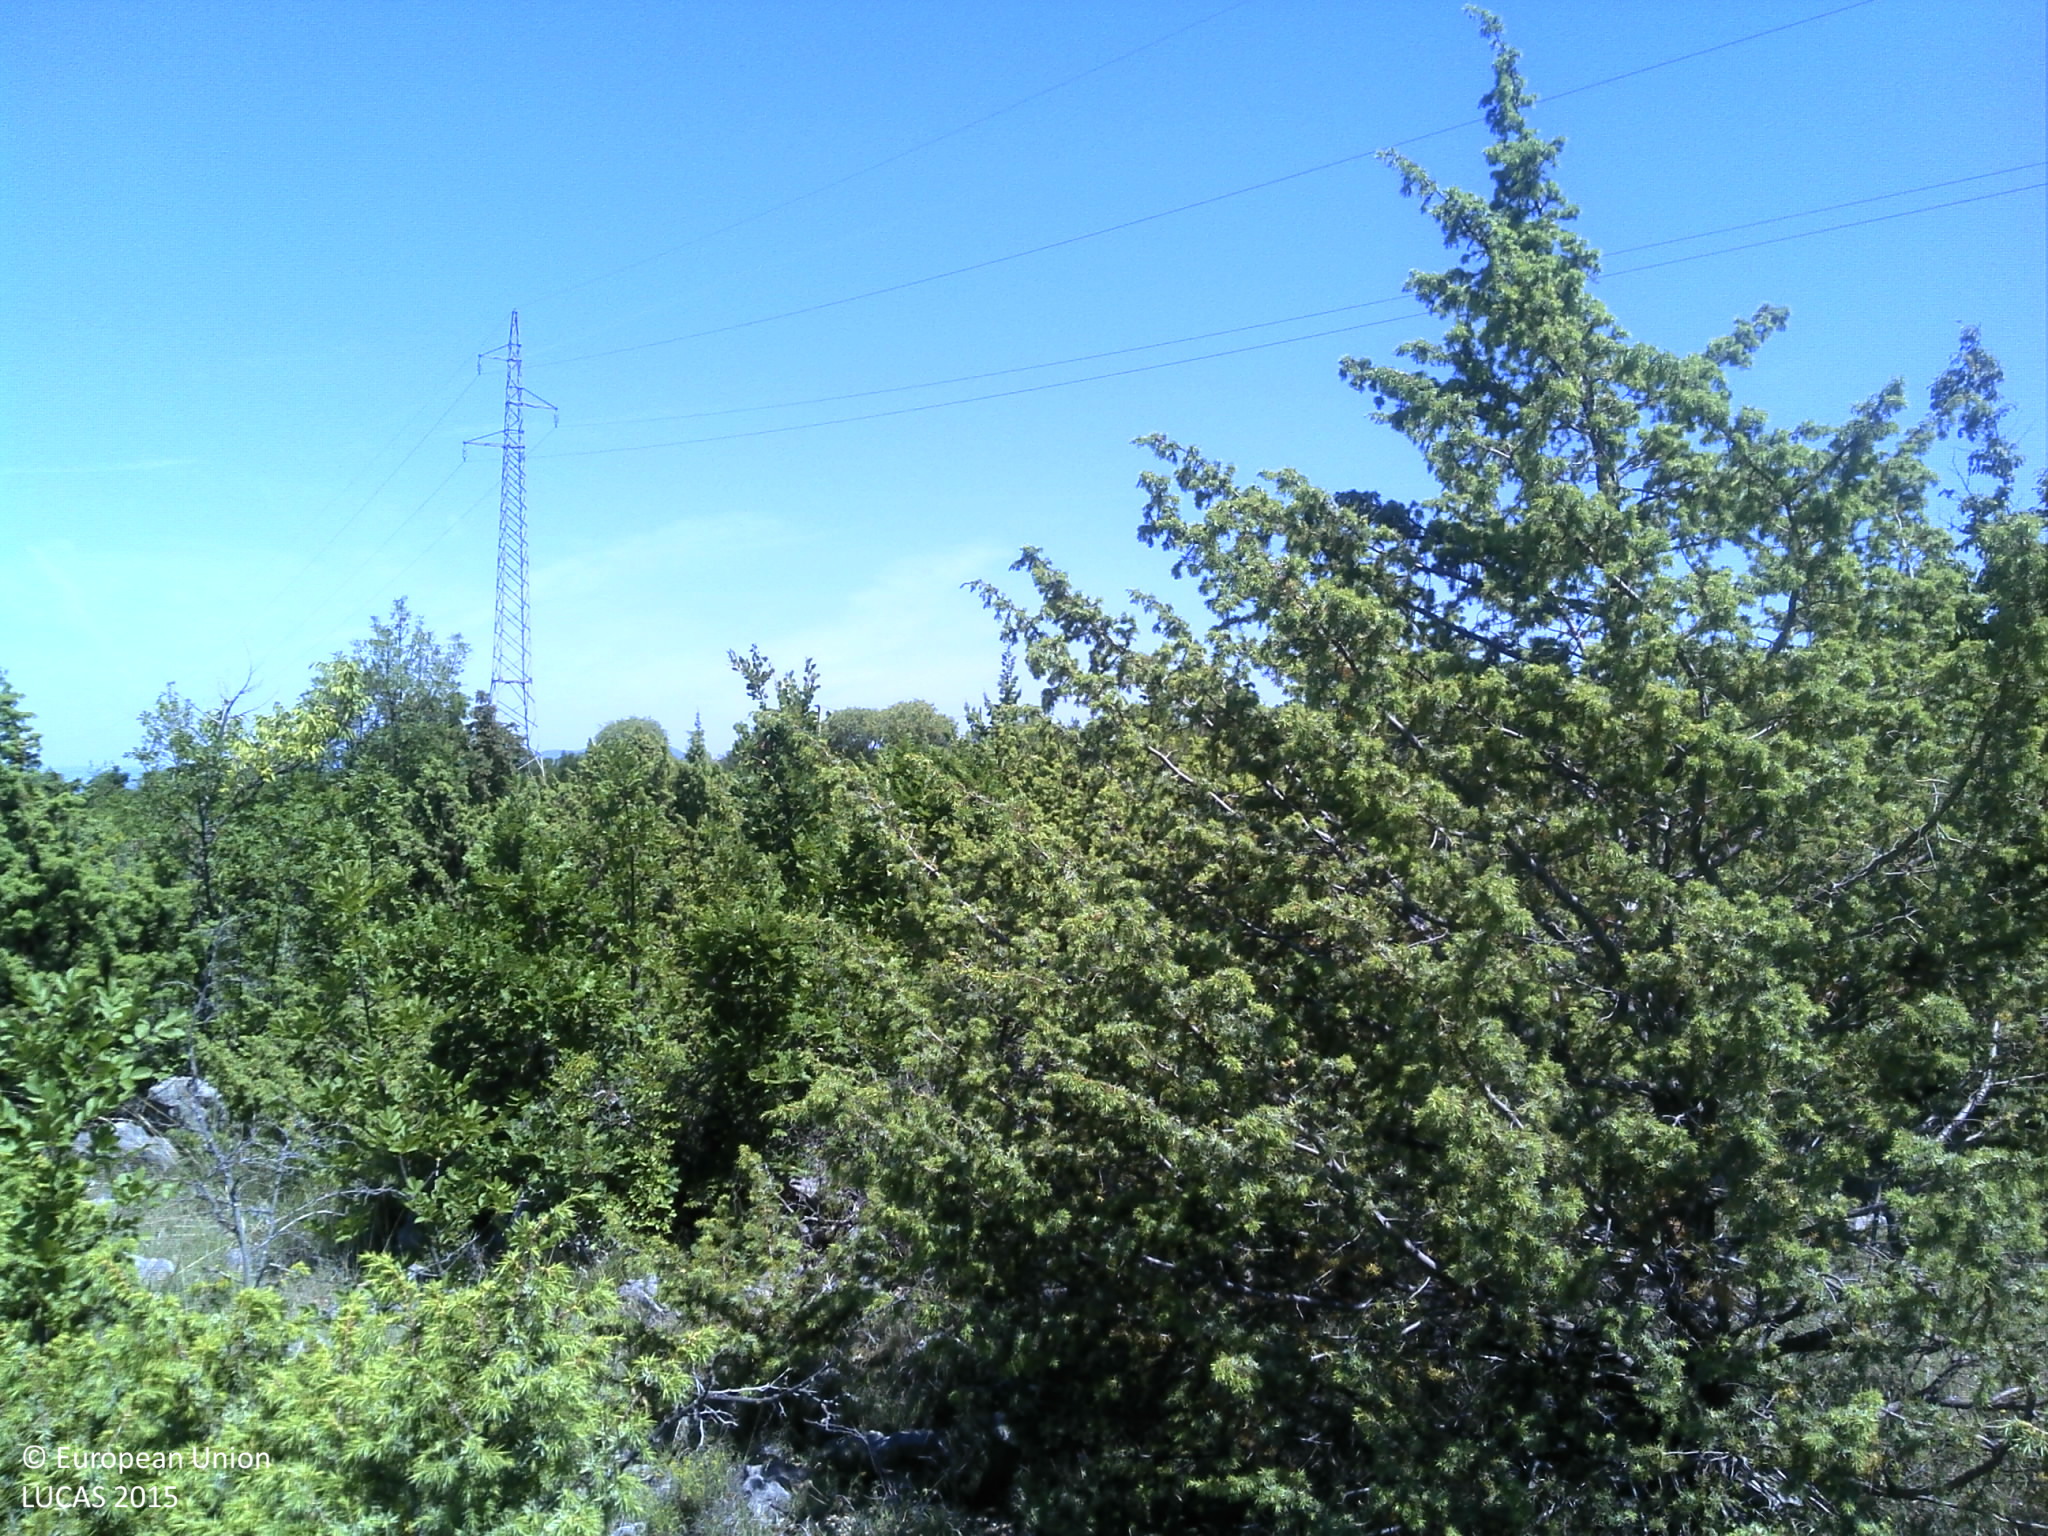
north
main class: Shrubland
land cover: Shrubland with sparse tree cover
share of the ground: 50 - 75 %
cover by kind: shrubs 50 %, herbaceous plants 35 %, unconsolidated bare surface 10 %, coniferous forest trees 5 %
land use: Semi-natural and natural areas not in use
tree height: < 5 m
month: May
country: HR
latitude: 43.9355
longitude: 16.1086
